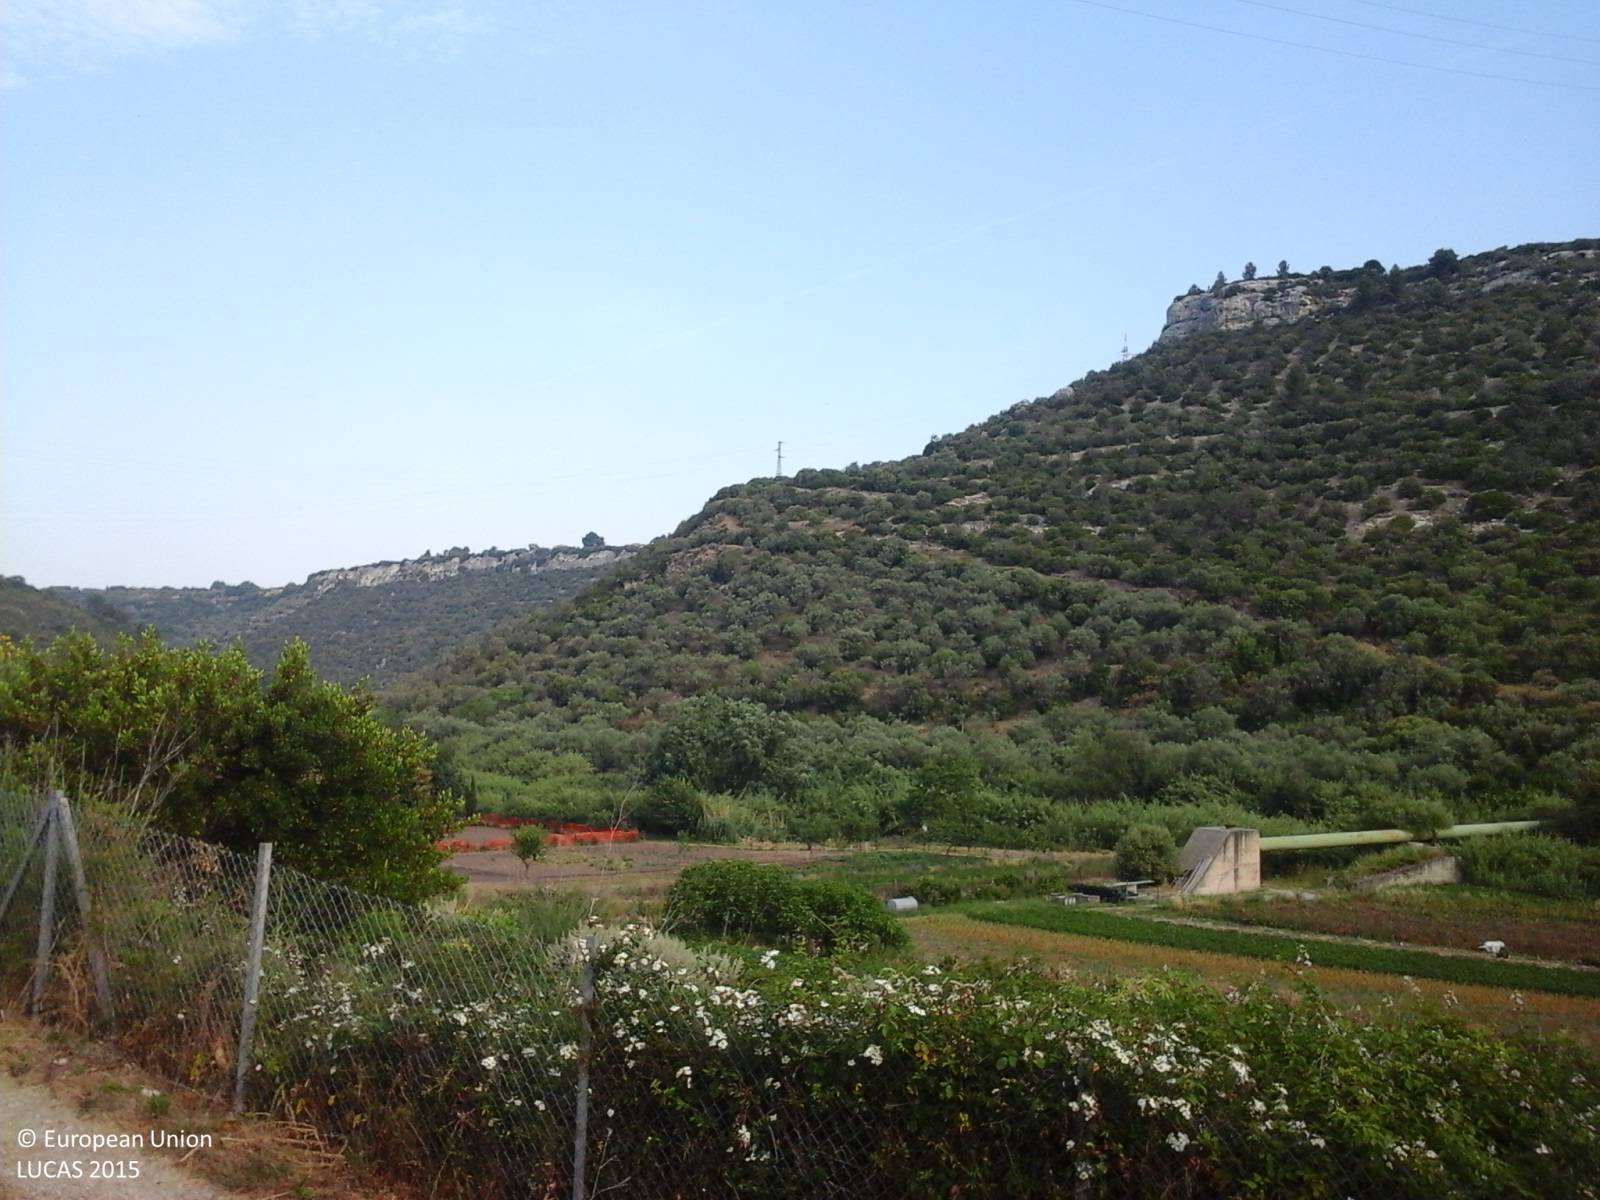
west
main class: Shrubland
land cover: Shrubland without tree cover
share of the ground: > 75 %
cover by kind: shrubs 85 %, herbaceous plants 15 %
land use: Semi-natural and natural areas not in use
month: June
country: IT
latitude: 40.6914
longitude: 8.5751
